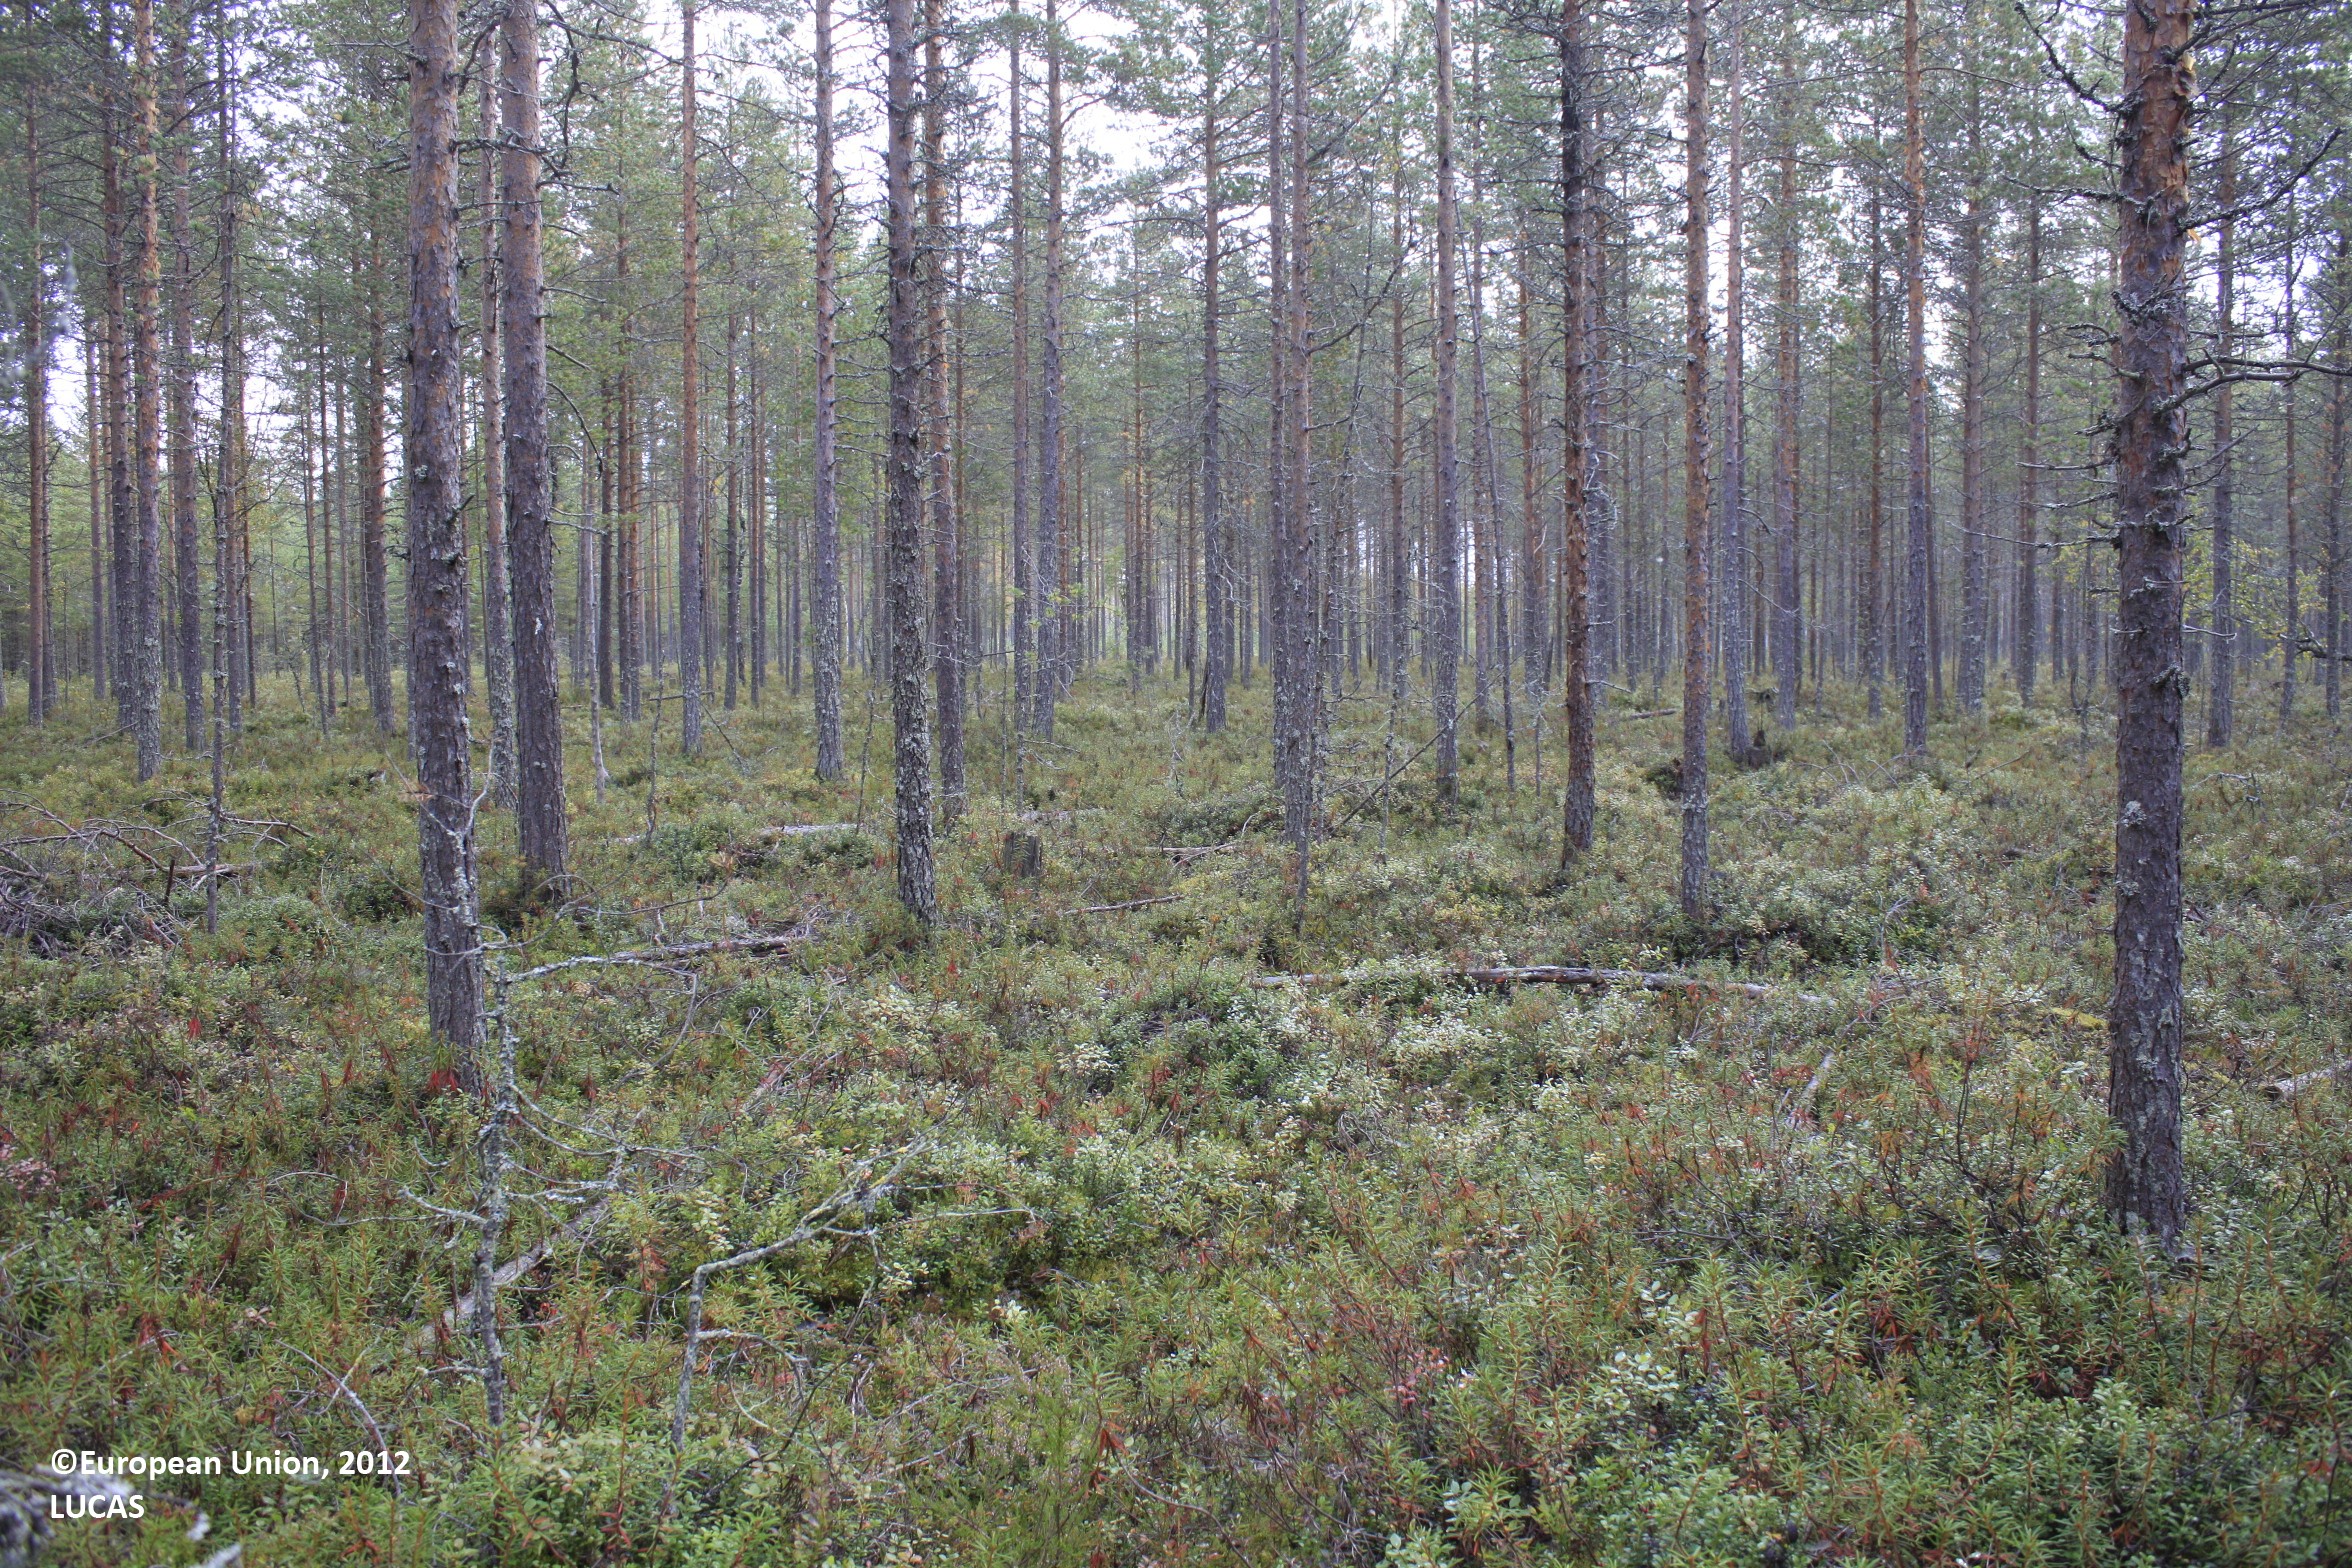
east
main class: Woodland
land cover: Pine dominated coniferous woodland
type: boreal forest
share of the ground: 25 - 50 %
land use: Forestry
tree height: > 5 m
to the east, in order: Pine dominated coniferous woodland; Ditches and canals; Pine dominated coniferous woodland; Ditches and canals; Pine dominated coniferous woodland; Ditches and canals; Pine dominated coniferous woodland; Ditches and canals; Pine dominated coniferous woodland; Ditches and canals; Pine dominated coniferous woodland
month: September
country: FI
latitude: 65.1096
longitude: 26.9626
